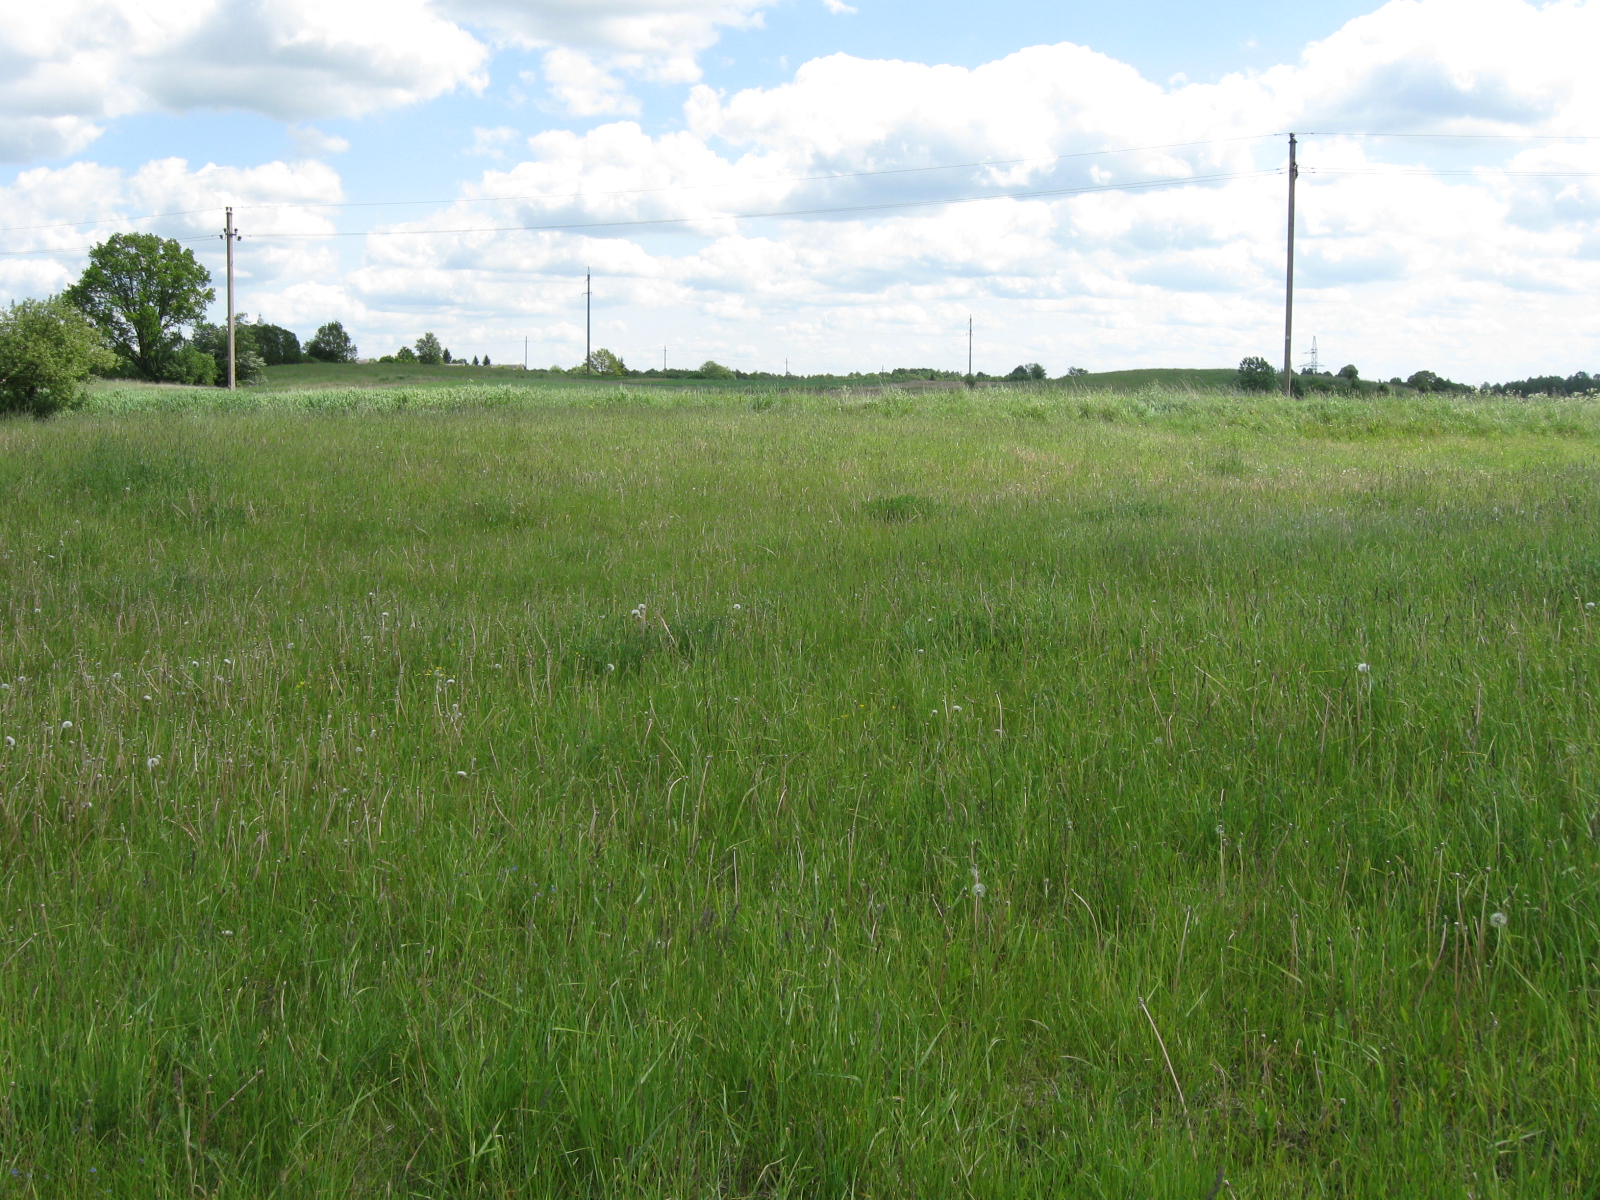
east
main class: Grassland
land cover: Grassland without tree/shrub cover
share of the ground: > 75 %
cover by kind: herbaceous plants 95 %, consolidated bare surface 5 %
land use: Agriculture (excluding fallow land and kitchen gardens)
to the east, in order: Grassland without tree/shrub cover; Paved roads, cycling and walking lanes; Shruby margins; Electric lines; Barley; Potatoes; Barley; Potatoes
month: May
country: LT
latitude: 54.3141
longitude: 23.2197
